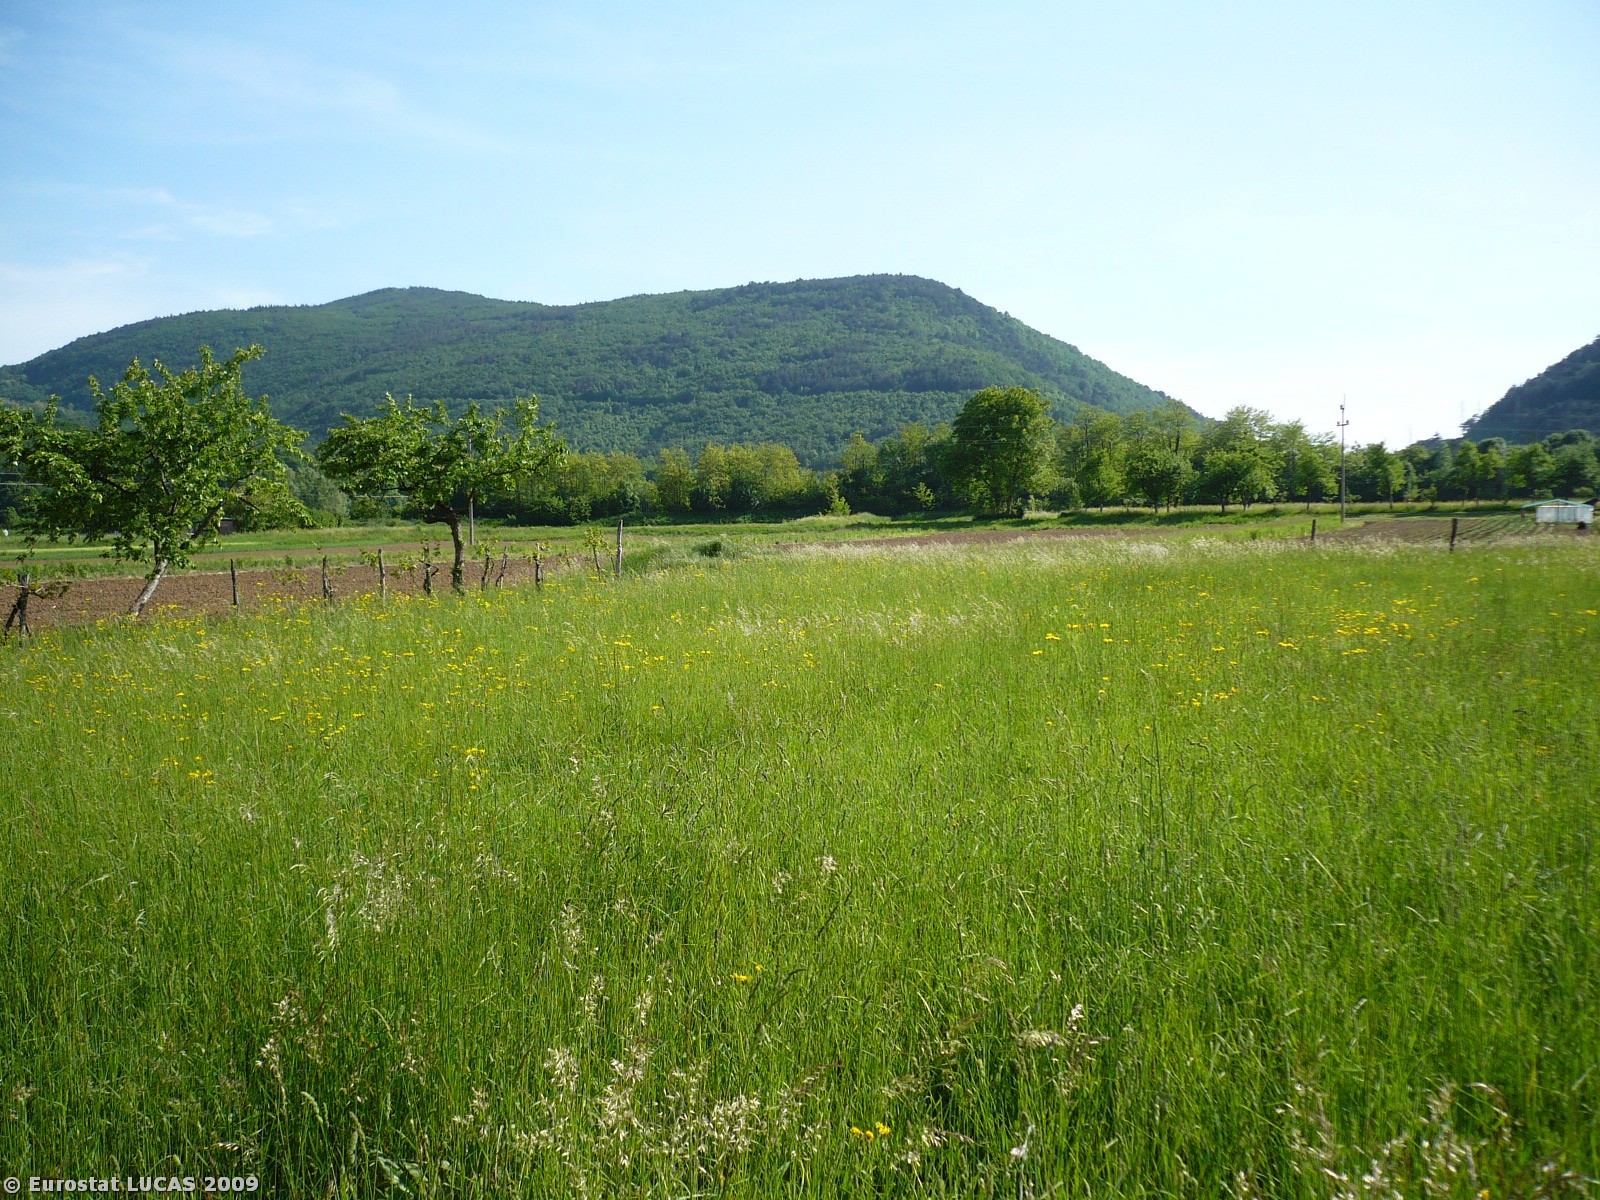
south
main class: Grassland
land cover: Grassland without tree/shrub cover
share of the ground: > 75 %
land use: Agriculture (excluding fallow land and kitchen gardens)
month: May
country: SI
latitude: 45.9995
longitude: 13.6762
